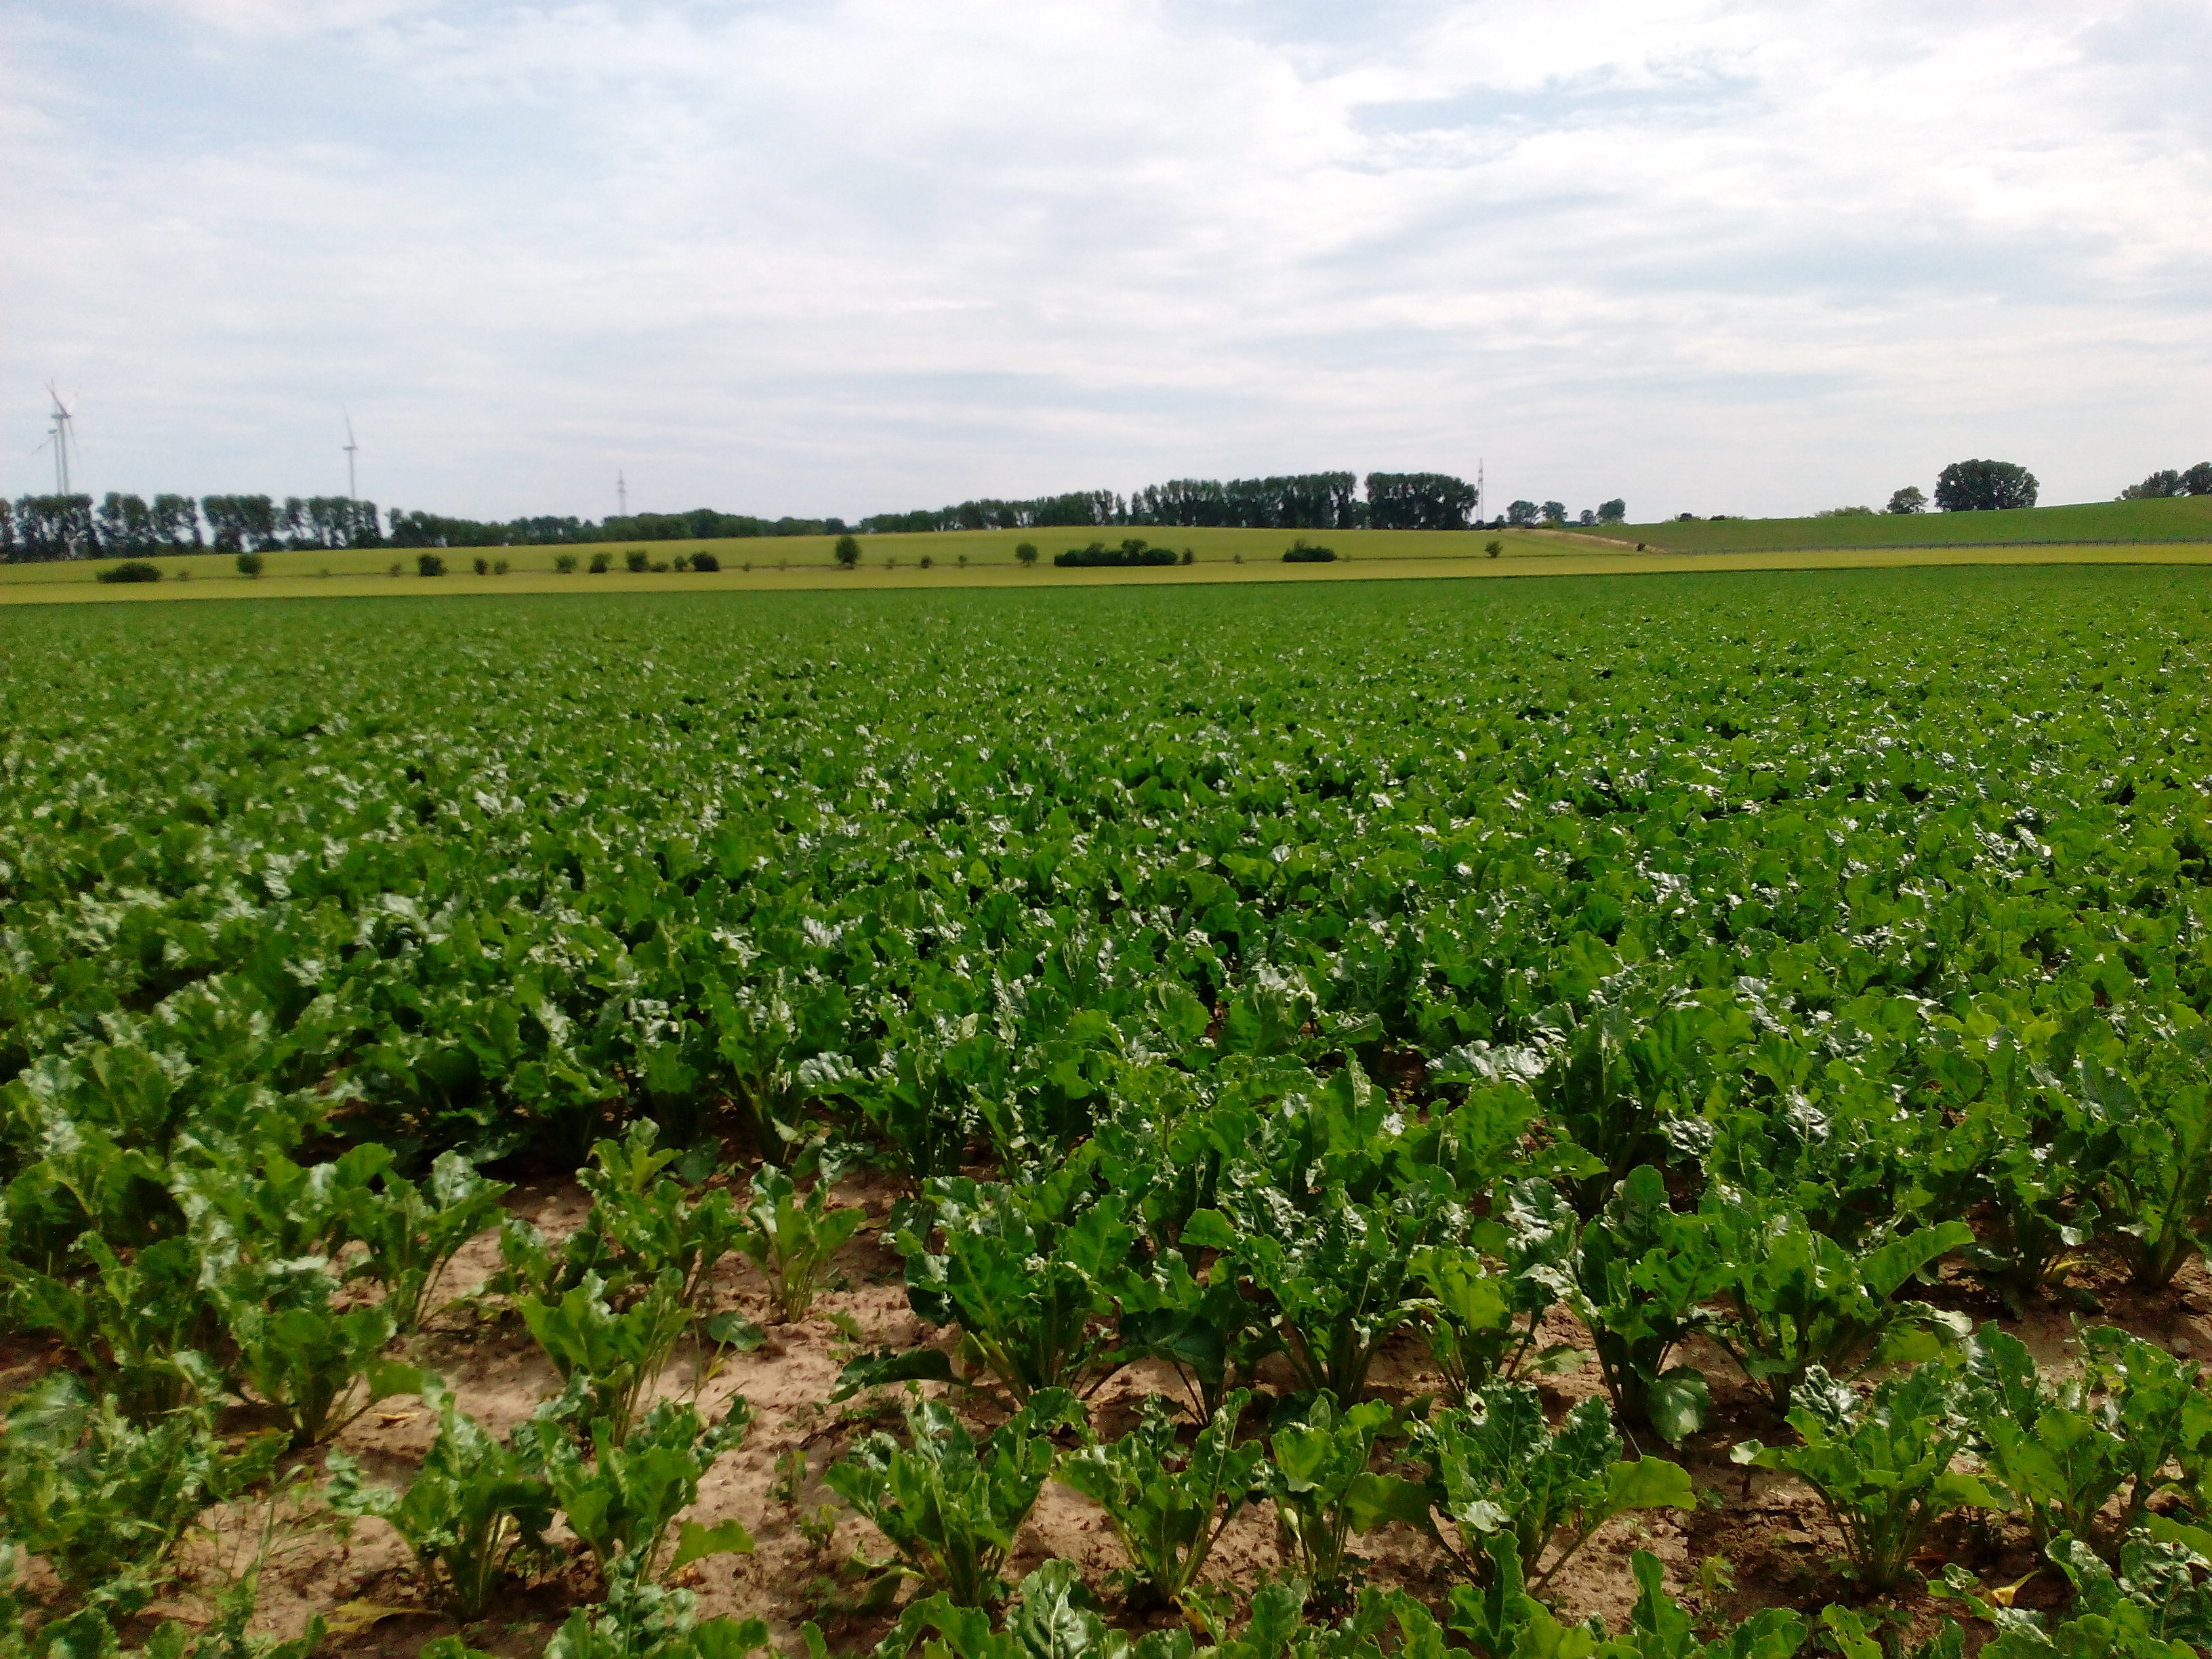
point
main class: Cropland
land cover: Sugar beet
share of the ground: > 75 %
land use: Agriculture (excluding fallow land and kitchen gardens)
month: June
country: DE
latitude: 51.2233
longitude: 10.9305
